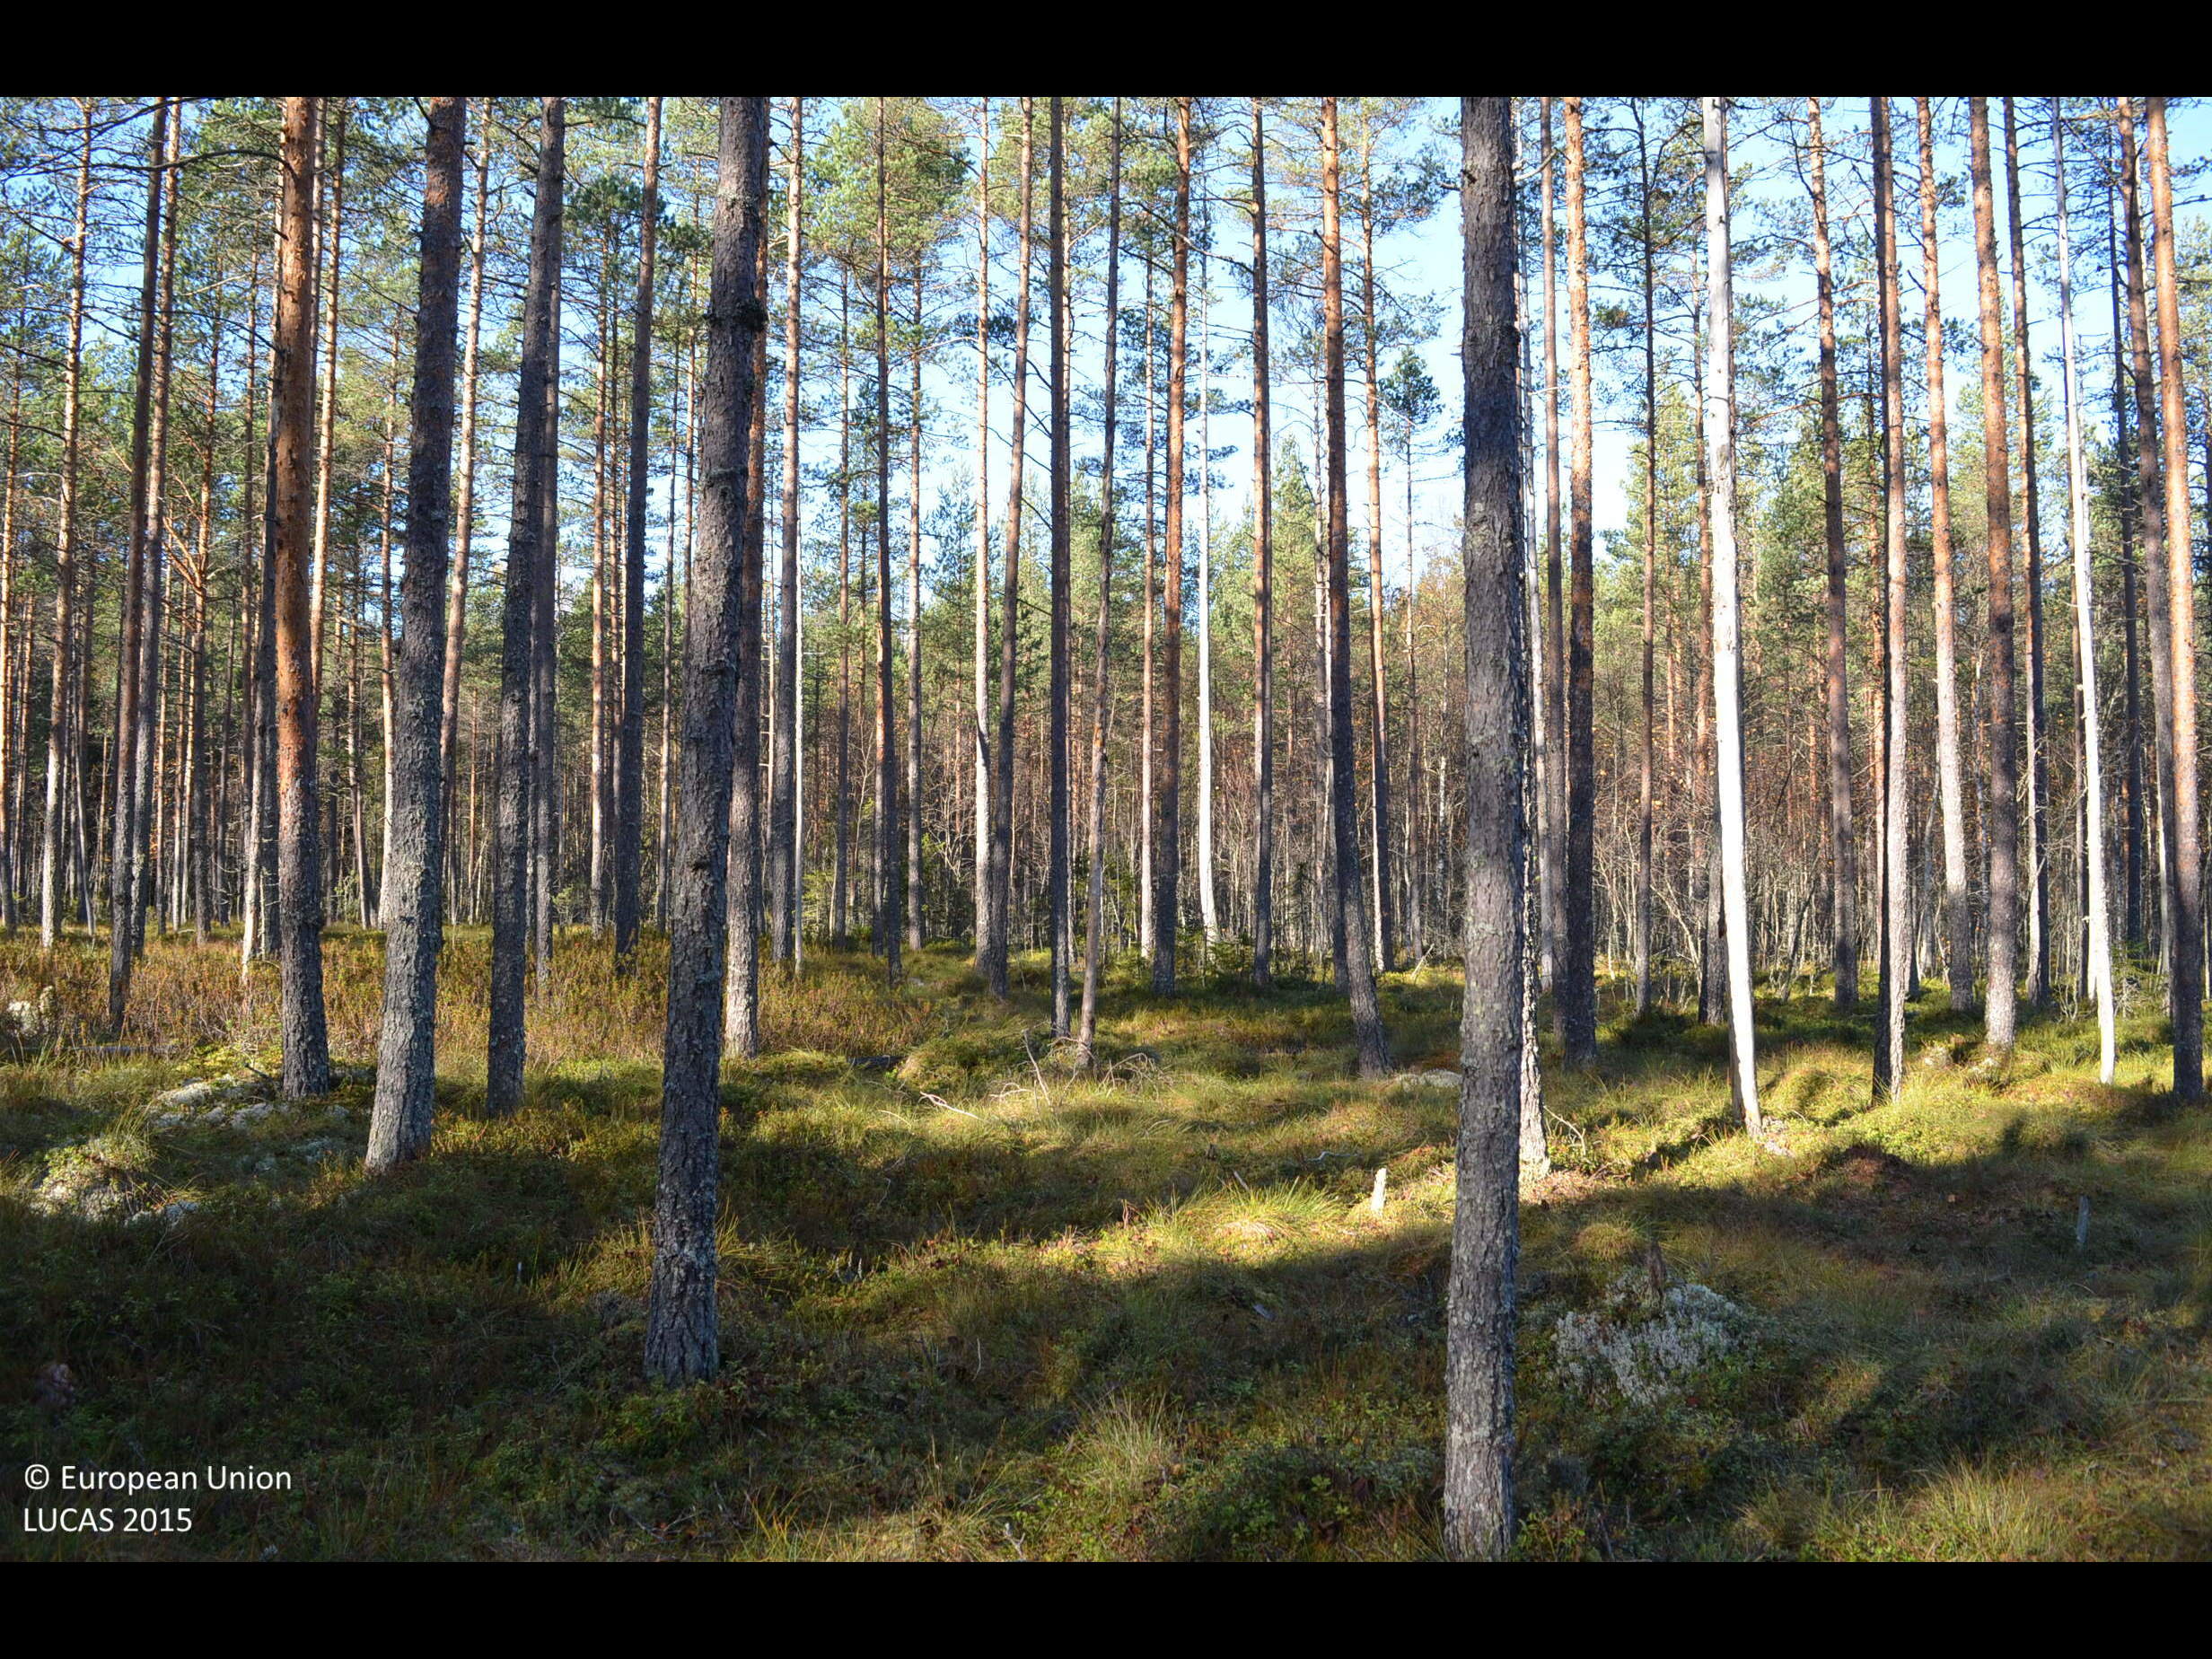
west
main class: Woodland
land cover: Pine dominated coniferous woodland
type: boreal forest
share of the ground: 50 - 75 %
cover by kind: coniferous forest trees 60 %, shrubs 15 %, lichens and mosses 15 %, herbaceous plants 10 %
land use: Forestry
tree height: > 5 m
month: October
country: FI
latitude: 61.7935
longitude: 23.9490
